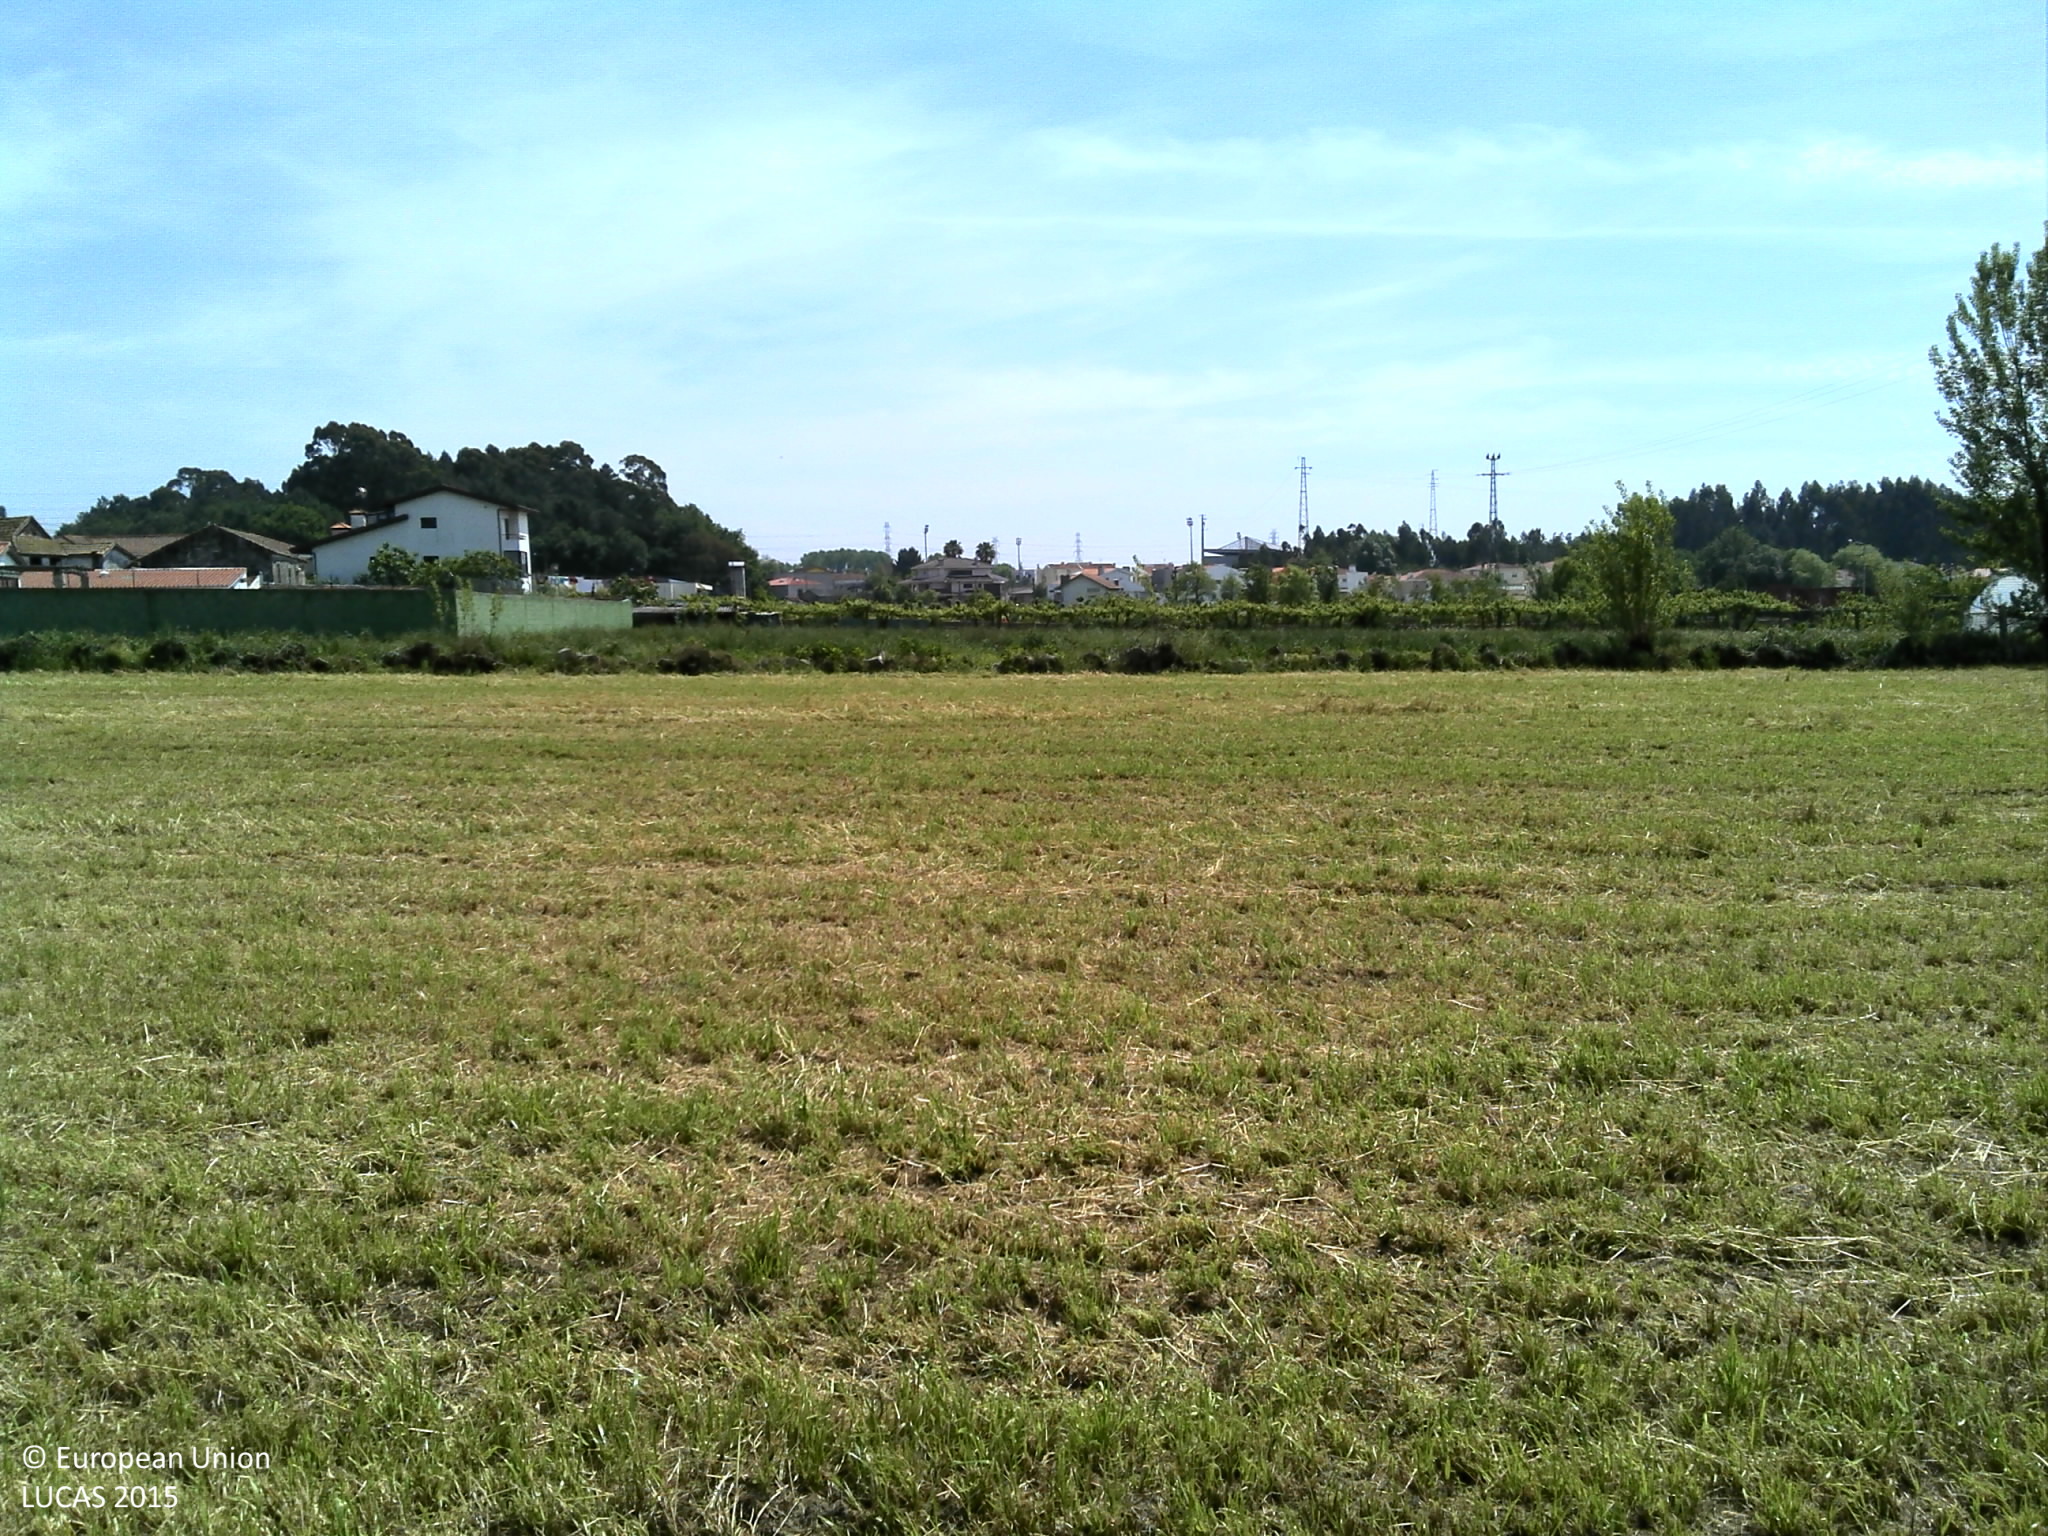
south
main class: Cropland
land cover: Temporary grasslands
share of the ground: > 75 %
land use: Agriculture (excluding fallow land and kitchen gardens)
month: May
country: PT
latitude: 41.2476
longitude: -8.5906
